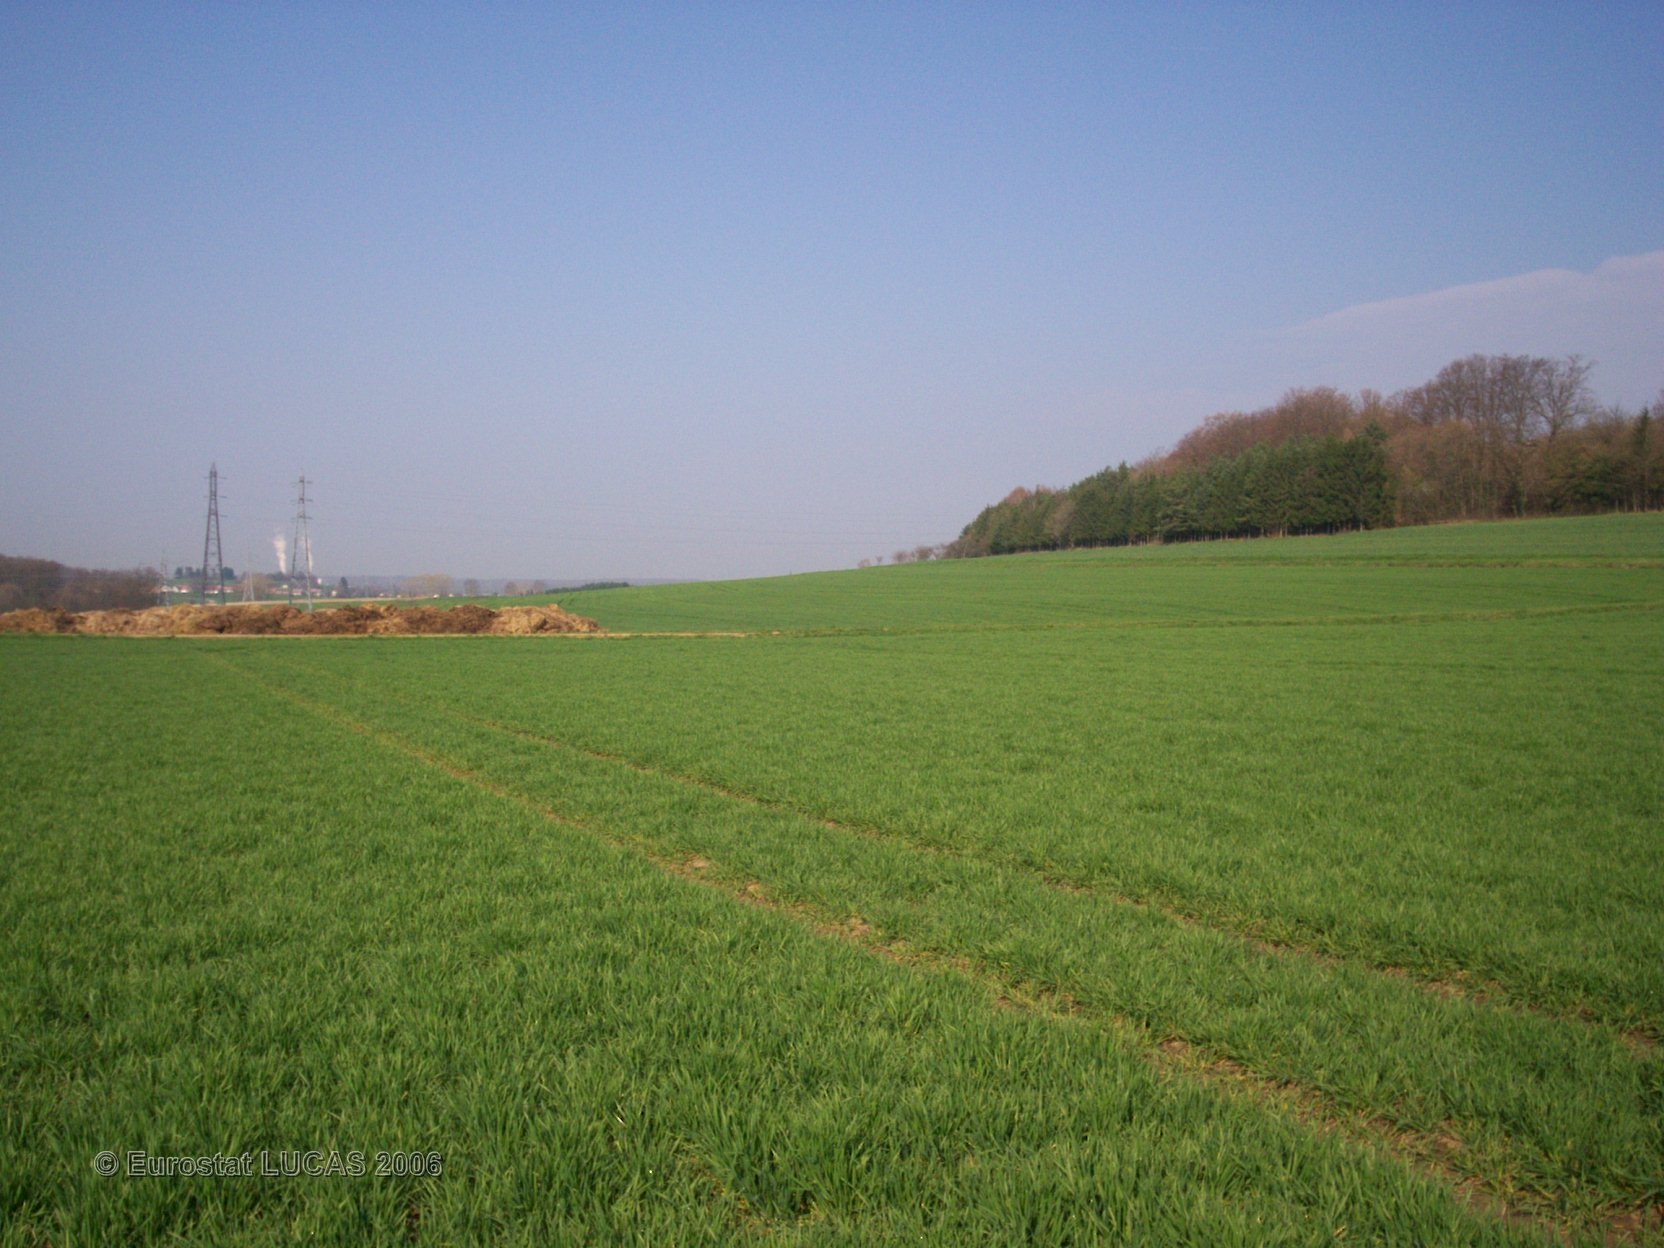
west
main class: Cropland
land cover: Barley
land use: Agriculture (excluding fallow land and kitchen gardens)
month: April
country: FR
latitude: 48.2216
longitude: 6.4876
